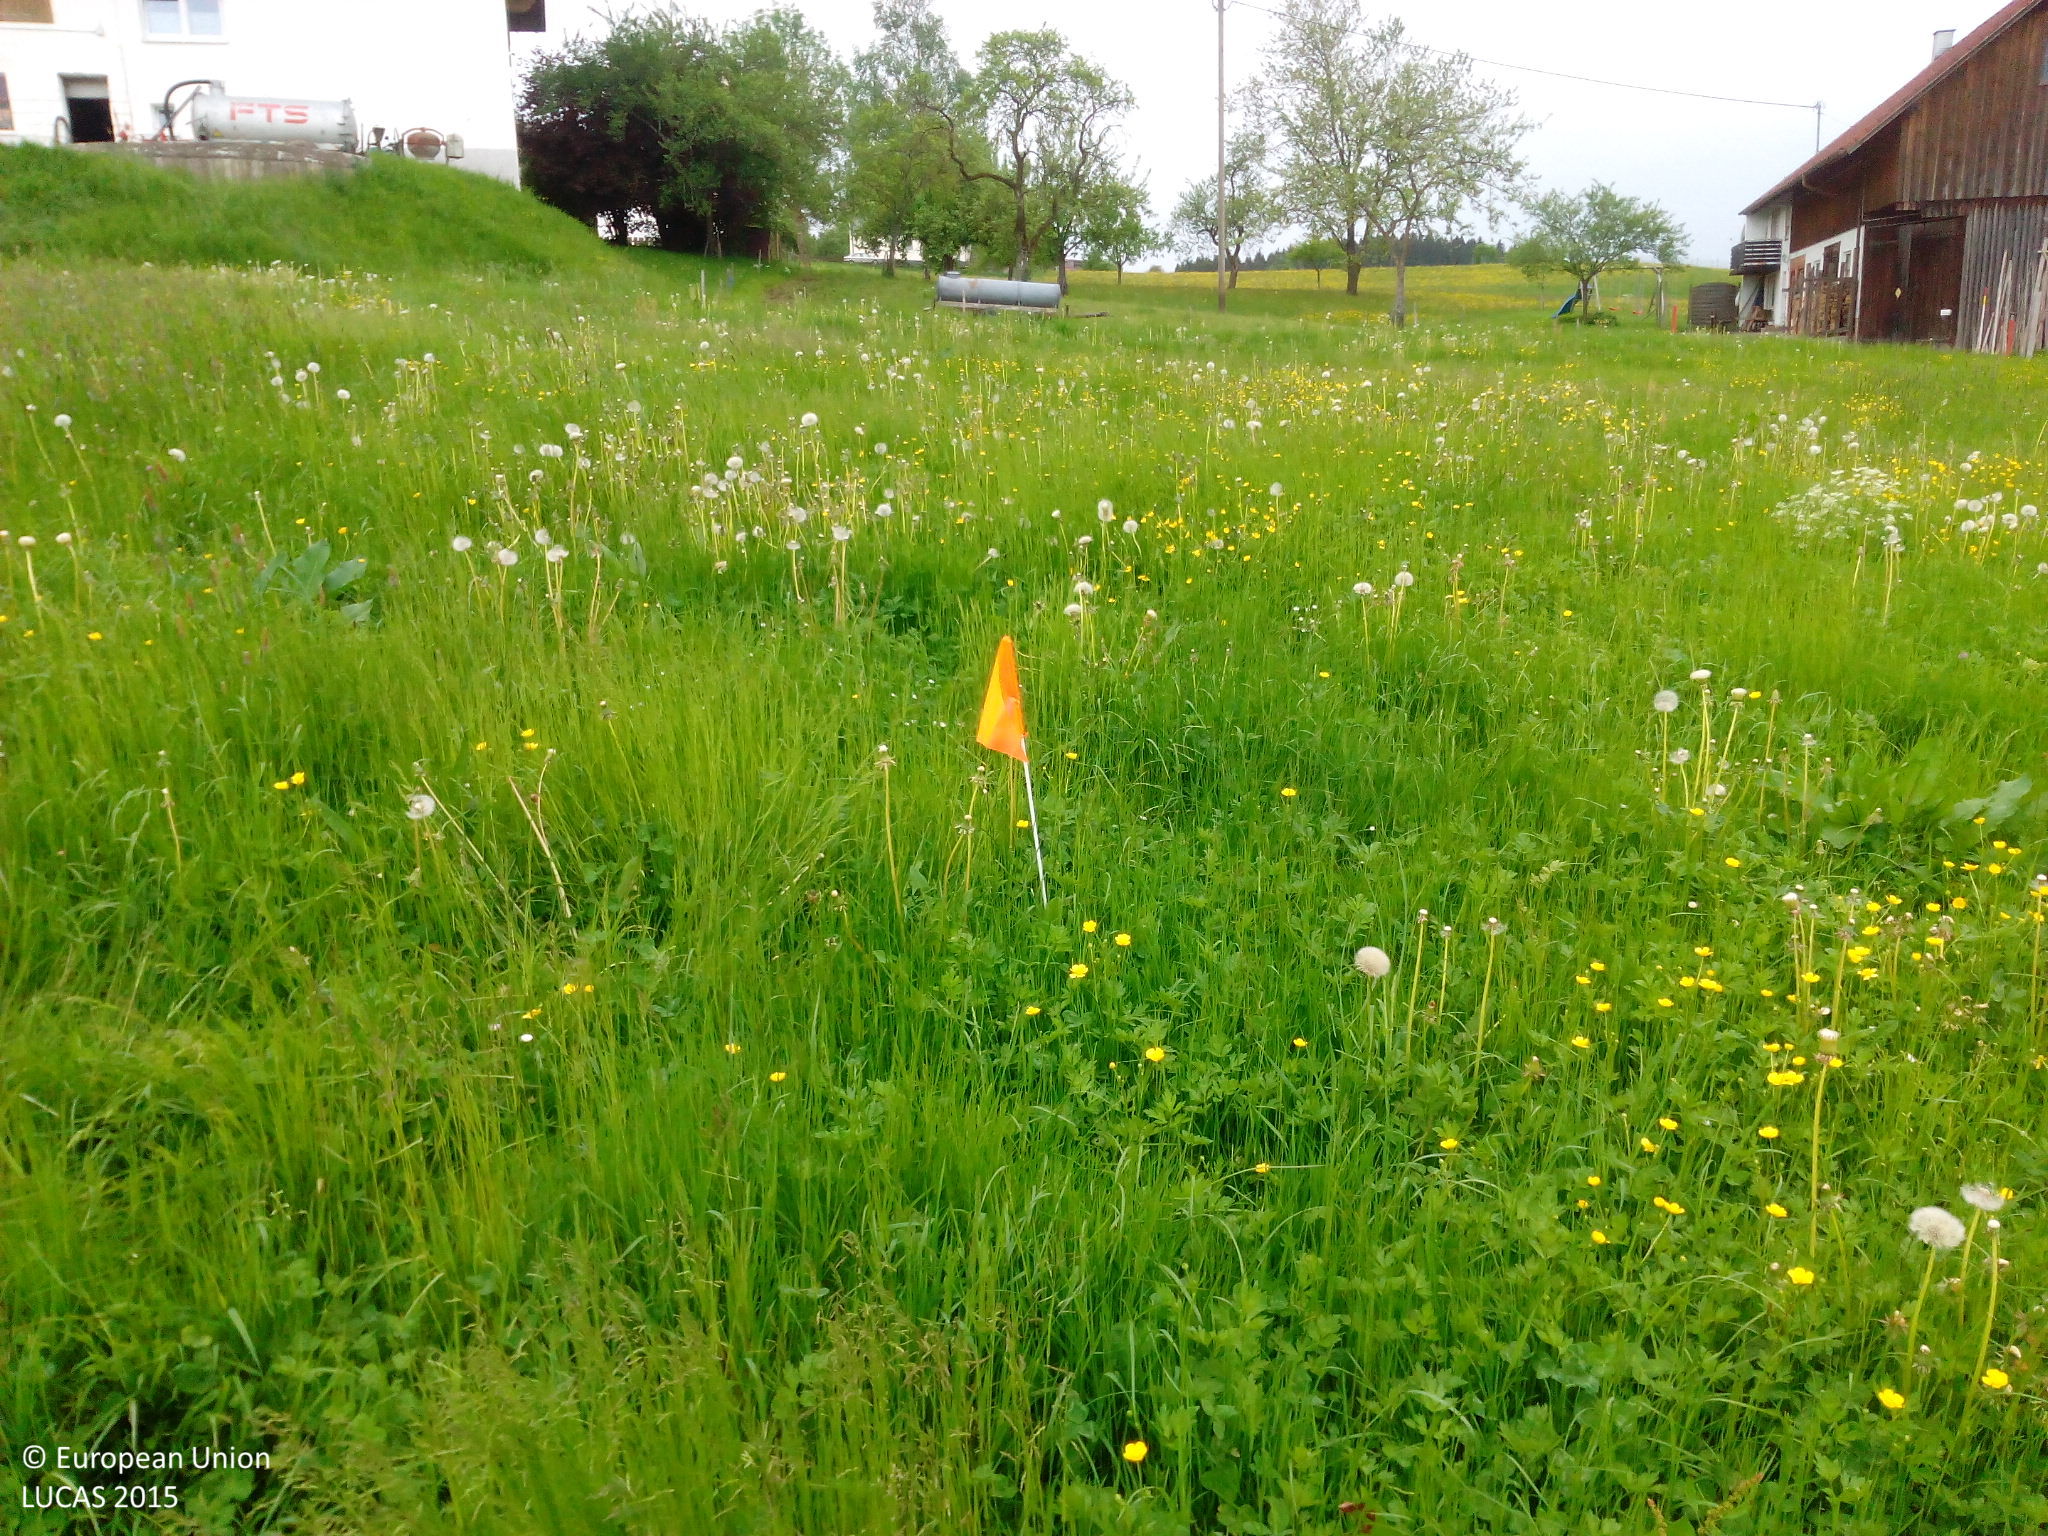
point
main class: Grassland
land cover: Grassland without tree/shrub cover
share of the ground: > 75 %
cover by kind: herbaceous plants 100 %
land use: Agriculture (excluding fallow land and kitchen gardens)
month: May
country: DE
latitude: 47.7916
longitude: 9.9333
